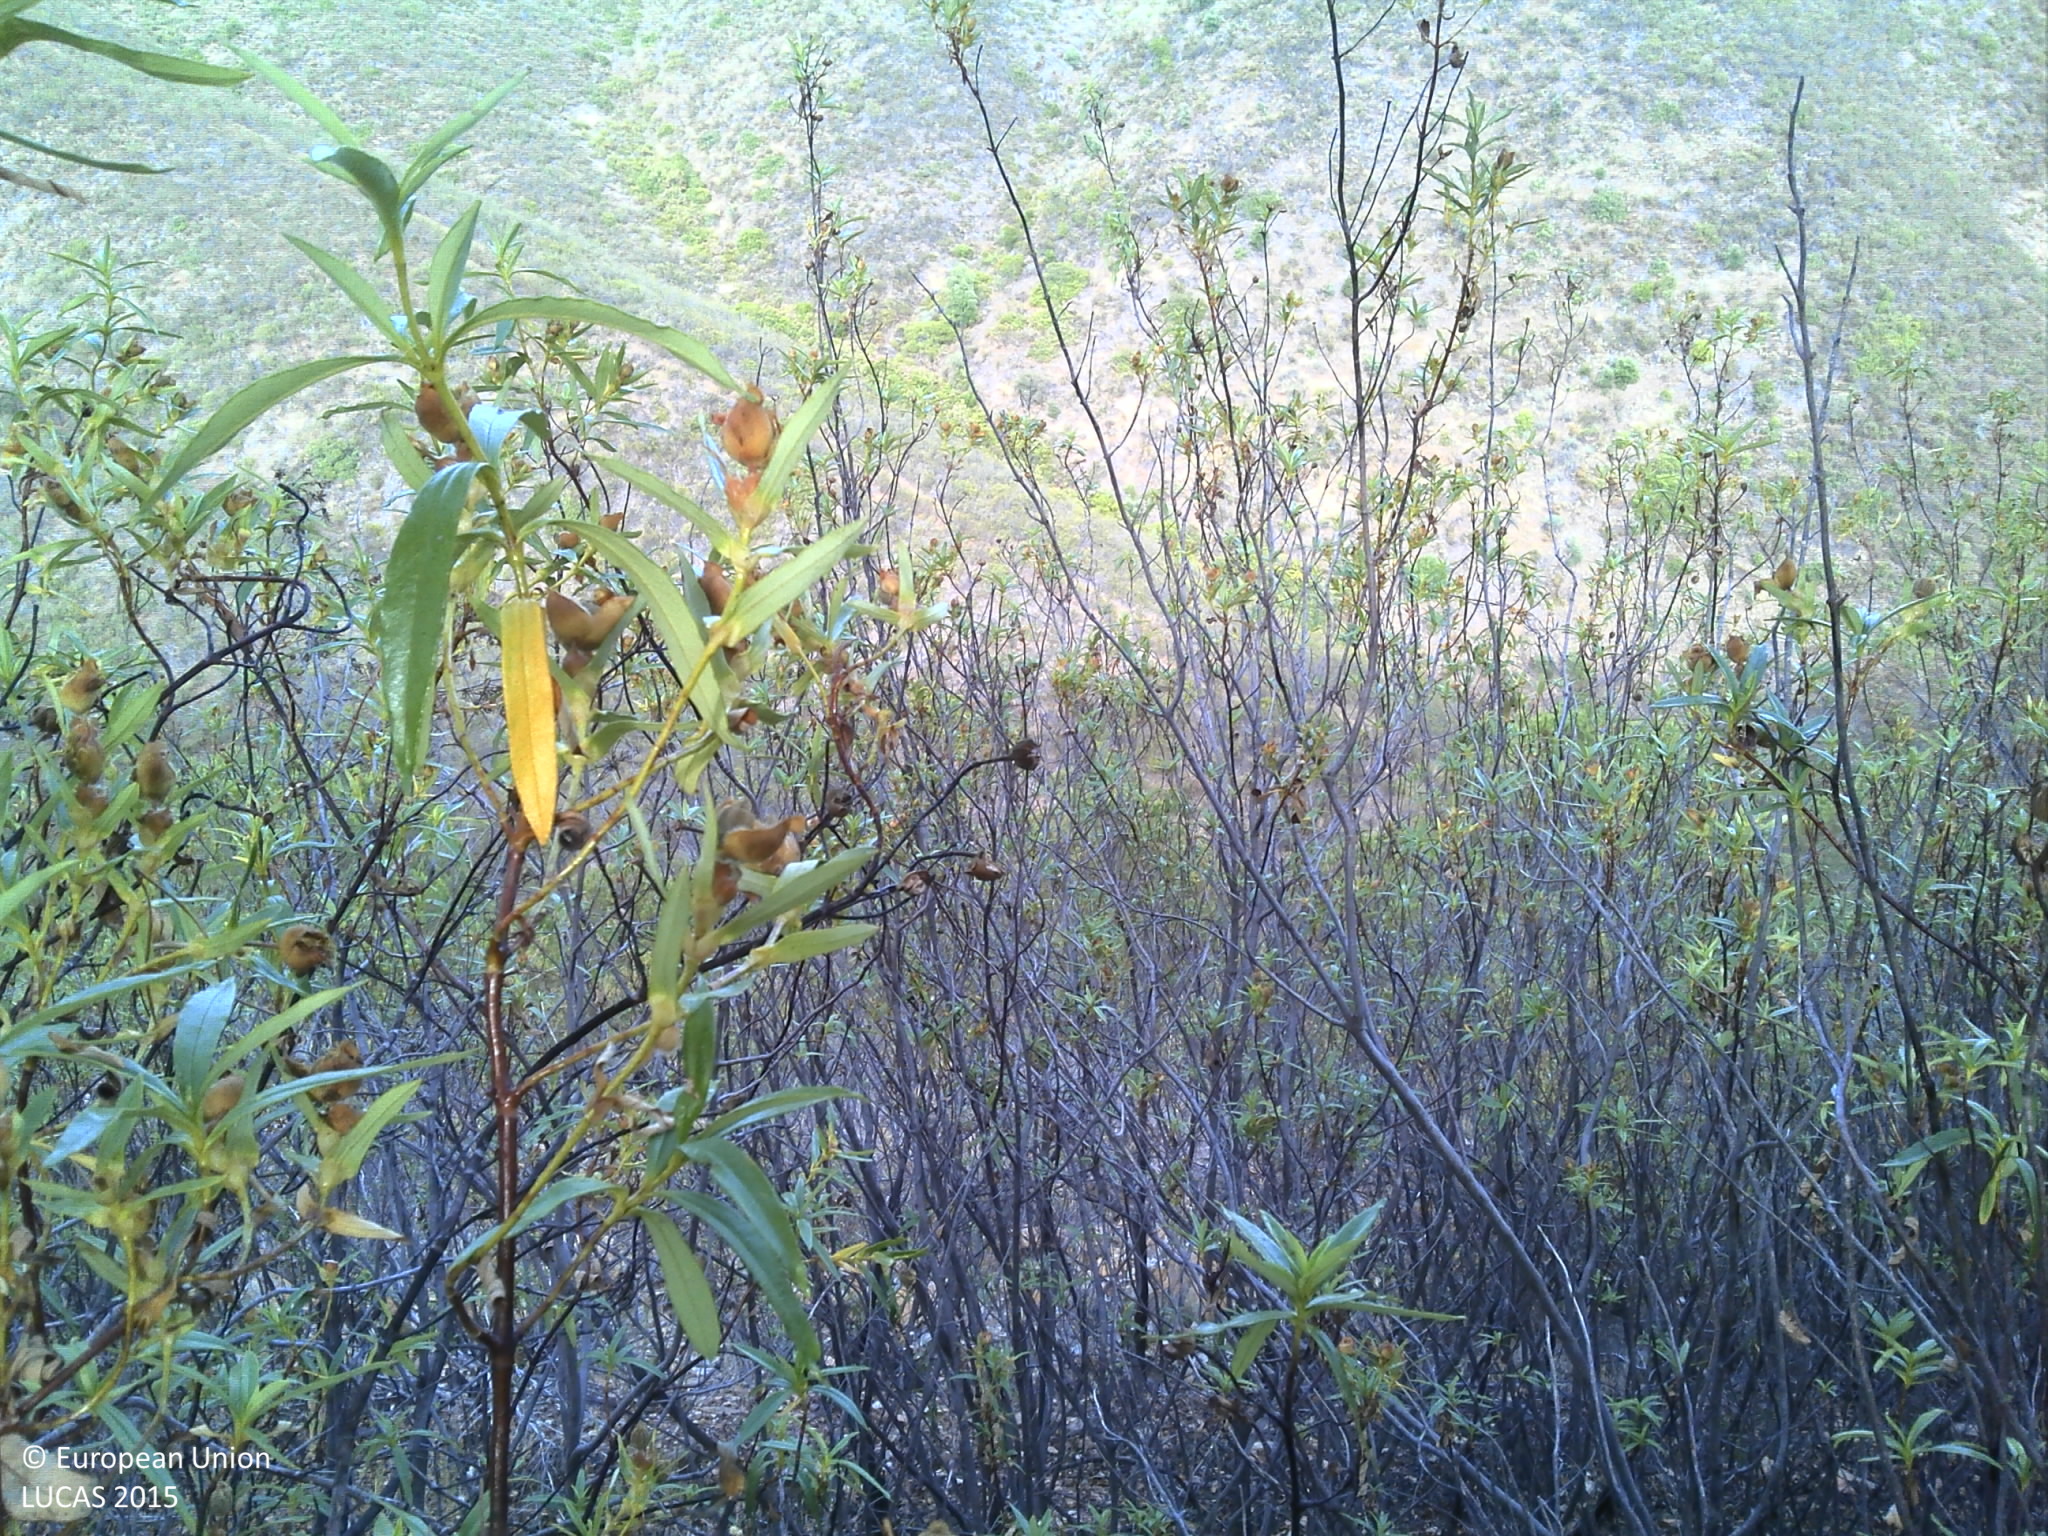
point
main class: Woodland
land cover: Pine dominated coniferous woodland
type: coniferous forest of the mediterranean region
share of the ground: 10 - 25 %
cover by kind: shrubs 90 %, coniferous forest trees 10 %
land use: Forestry
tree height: > 5 m
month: June
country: PT
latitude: 37.3454
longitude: -7.7222
